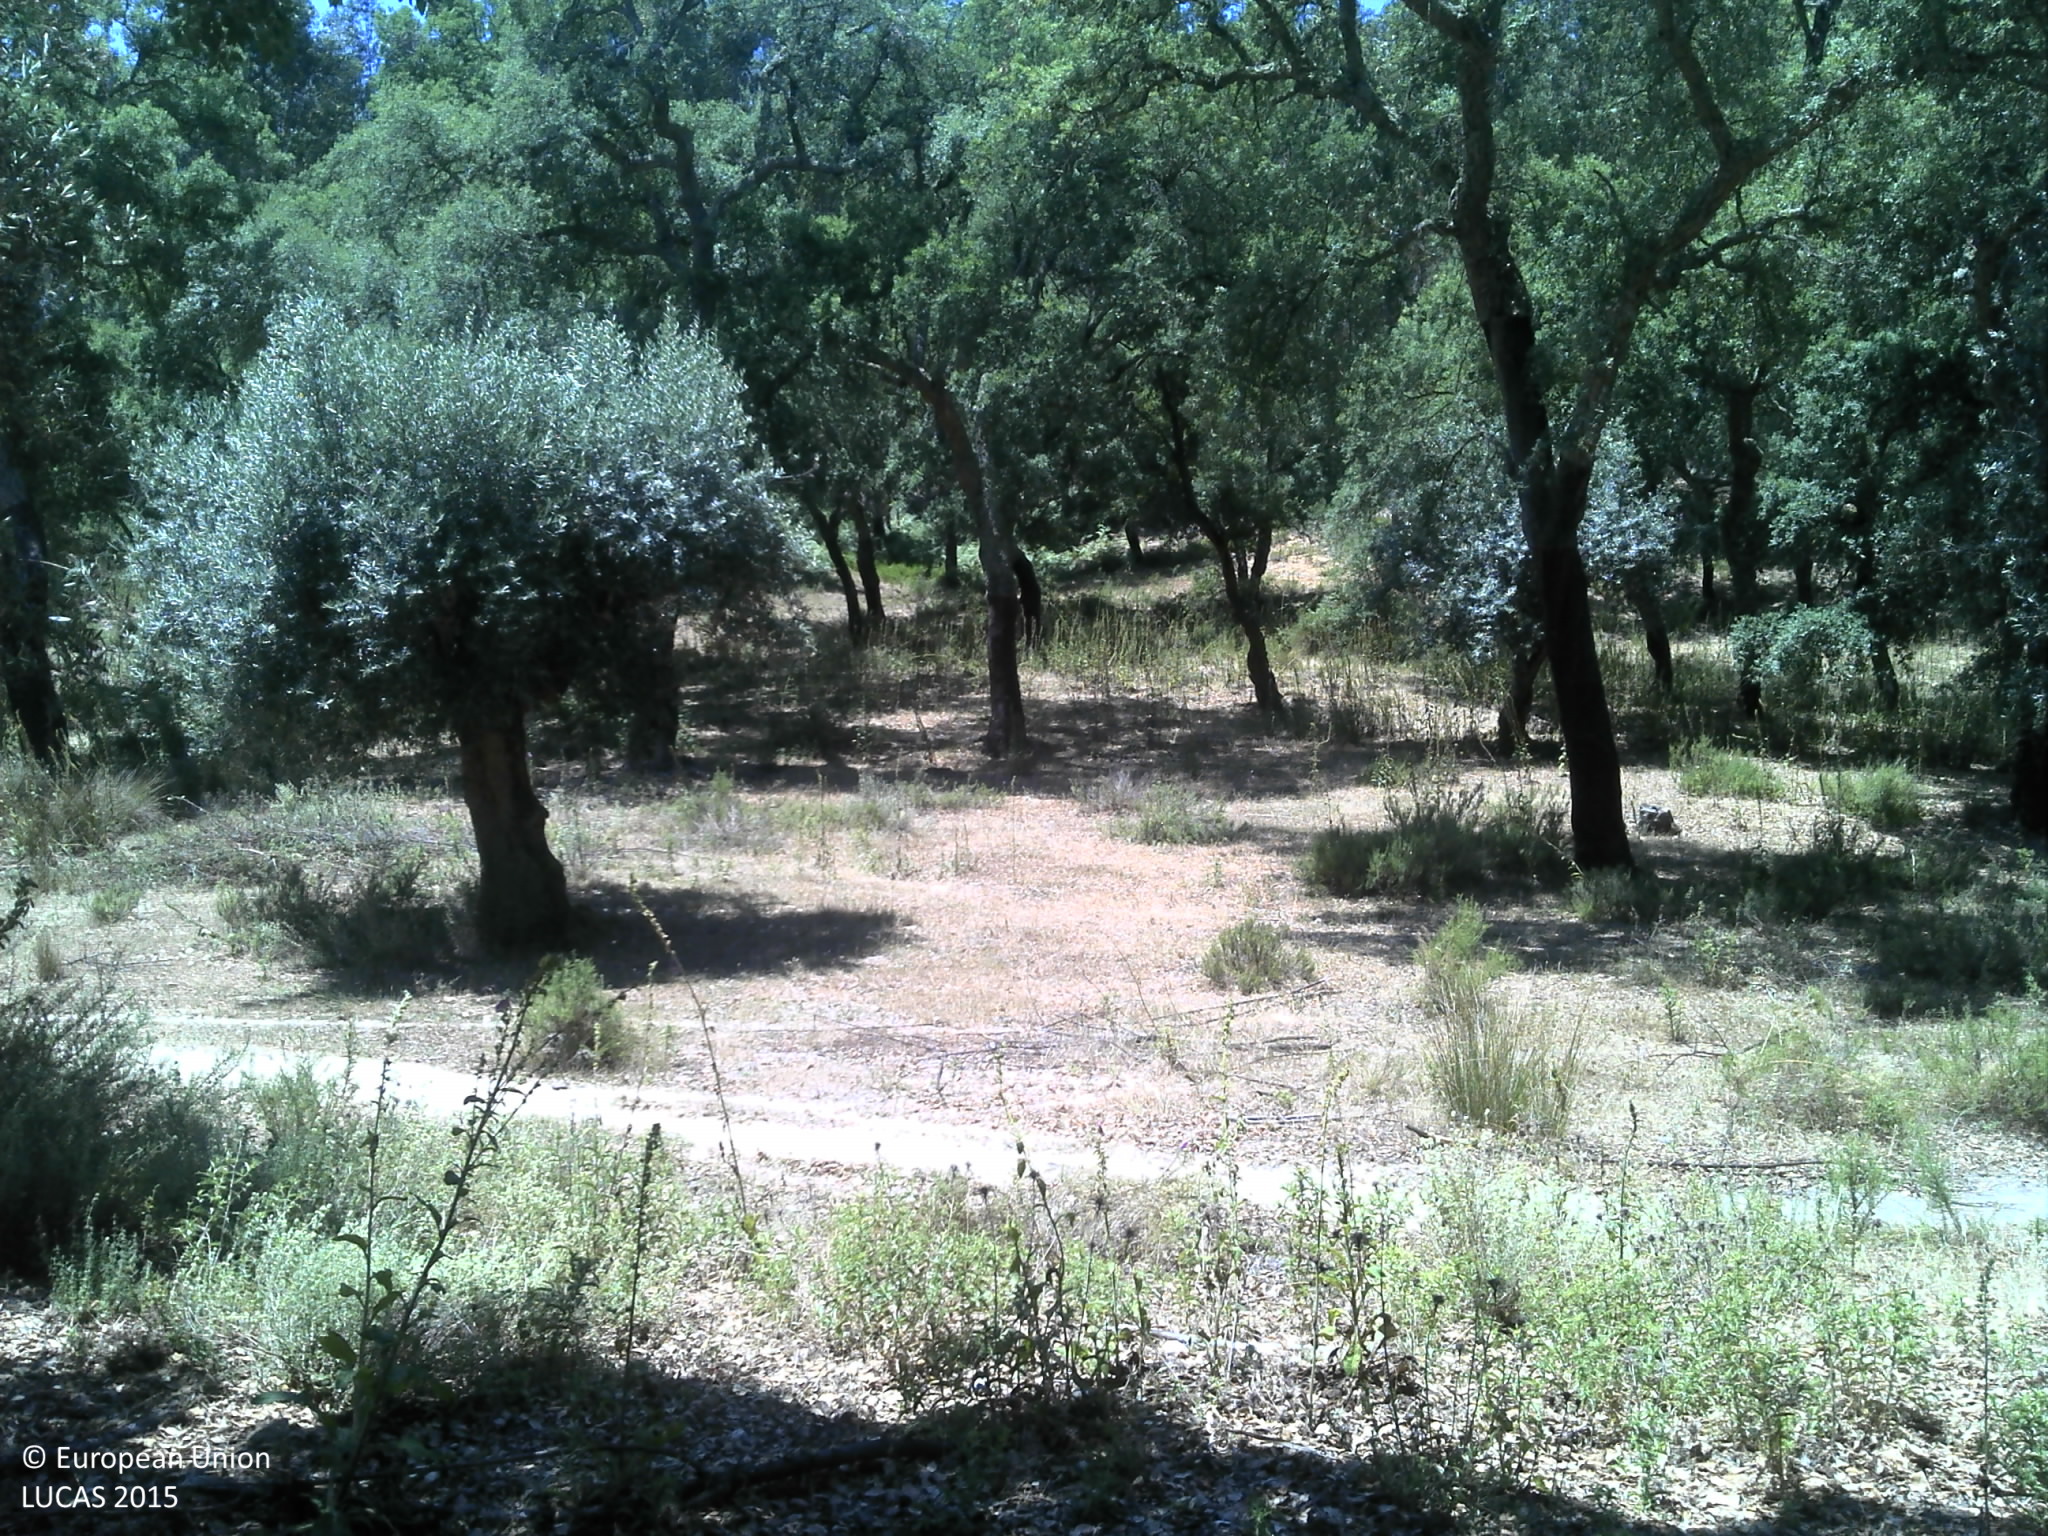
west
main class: Woodland
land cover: Broadleaved woodland
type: broadleaved evergreen forest
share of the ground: 25 - 50 %
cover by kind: broadleaved forest trees 50 %, unconsolidated bare surface 40 %, herbaceous plants 10 %
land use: Forestry
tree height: > 5 m
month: June
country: PT
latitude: 39.3096
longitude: -8.2826
